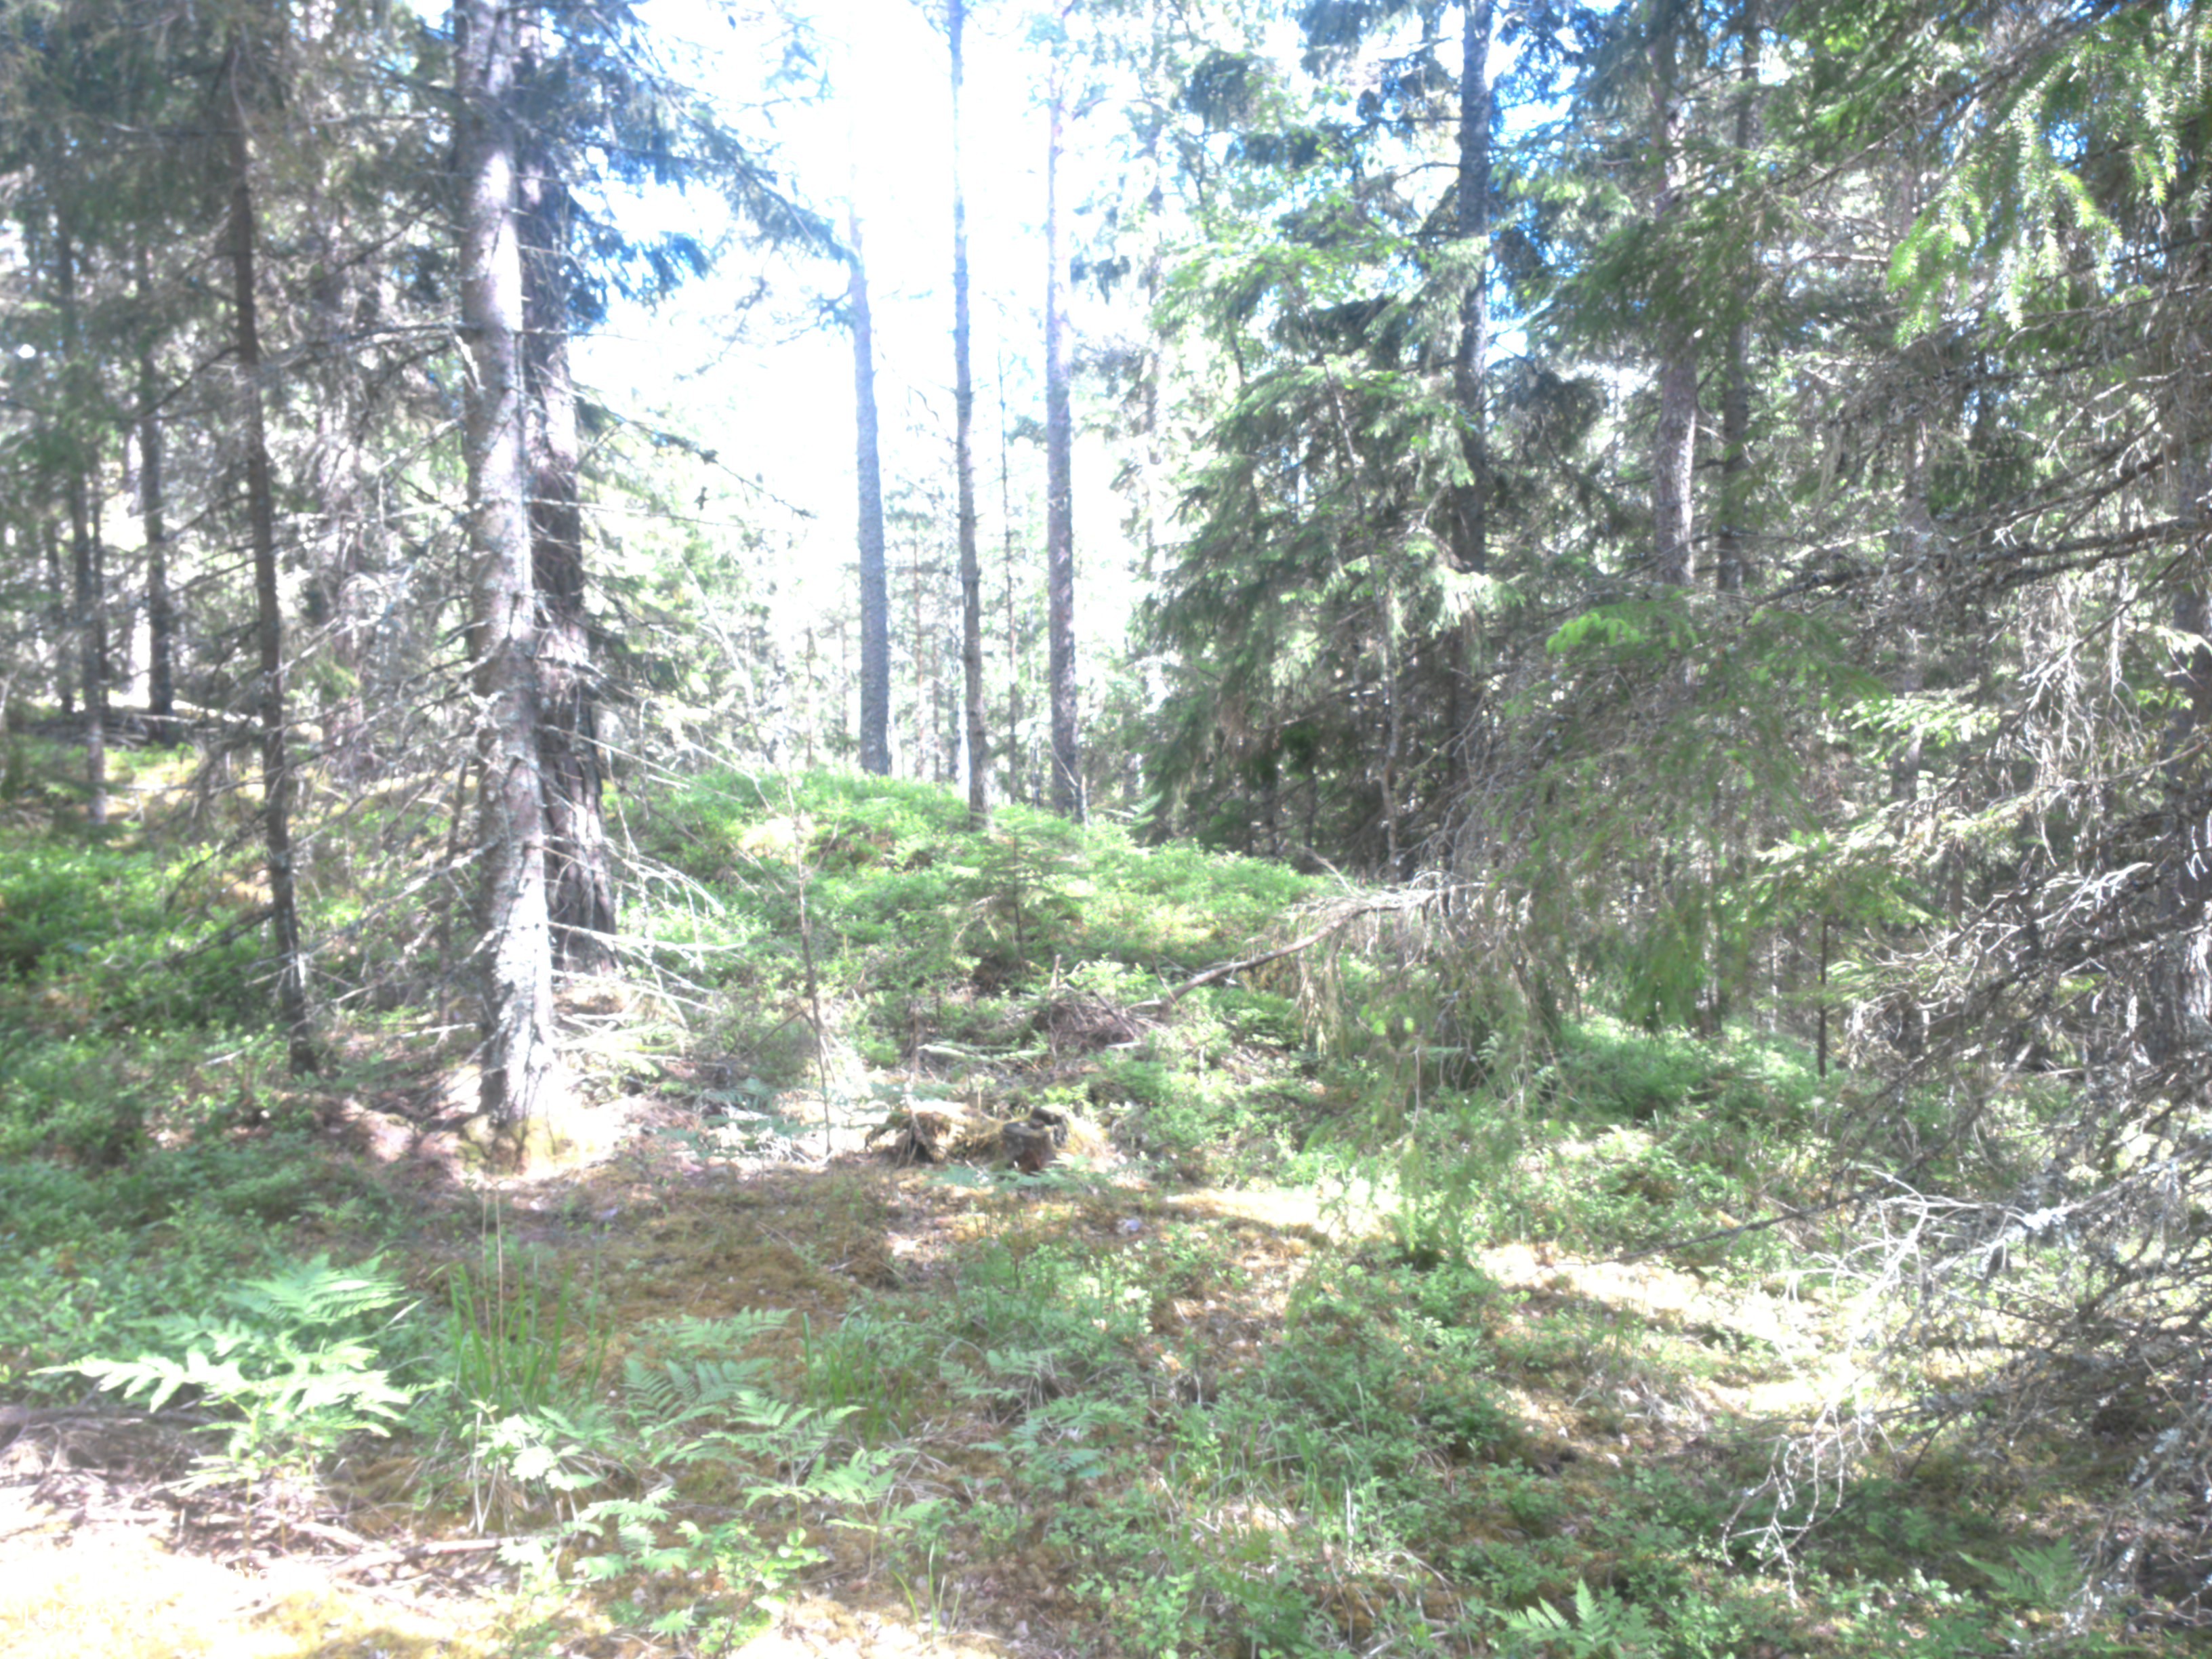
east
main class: Woodland
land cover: Other mixed woodland
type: boreal forest
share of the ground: 50 - 75 %
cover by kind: coniferous forest trees 40 %, herbaceous plants 25 %, broadleaved forest trees 15 %, shrubs 15 %, lichens and mosses 5 %
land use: Forestry
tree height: > 5 m
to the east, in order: Other mixed woodland; Rock outcrops; Spruce dominated mixed woodland; Paved roads, cycling and walking lanes; Ditches and canals; Grassland without tree/shrub cover; Rocks and stones; Electric lines; Grassland without tree/shrub cover; Pine dominated mixed woodland; Ditches and canals; Pine dominated mixed woodland; Broadleaved woodland; Spruce dominated coniferous woodland; Spruce dominated mixed woodland
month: June
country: SE
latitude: 59.0528
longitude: 11.8262
